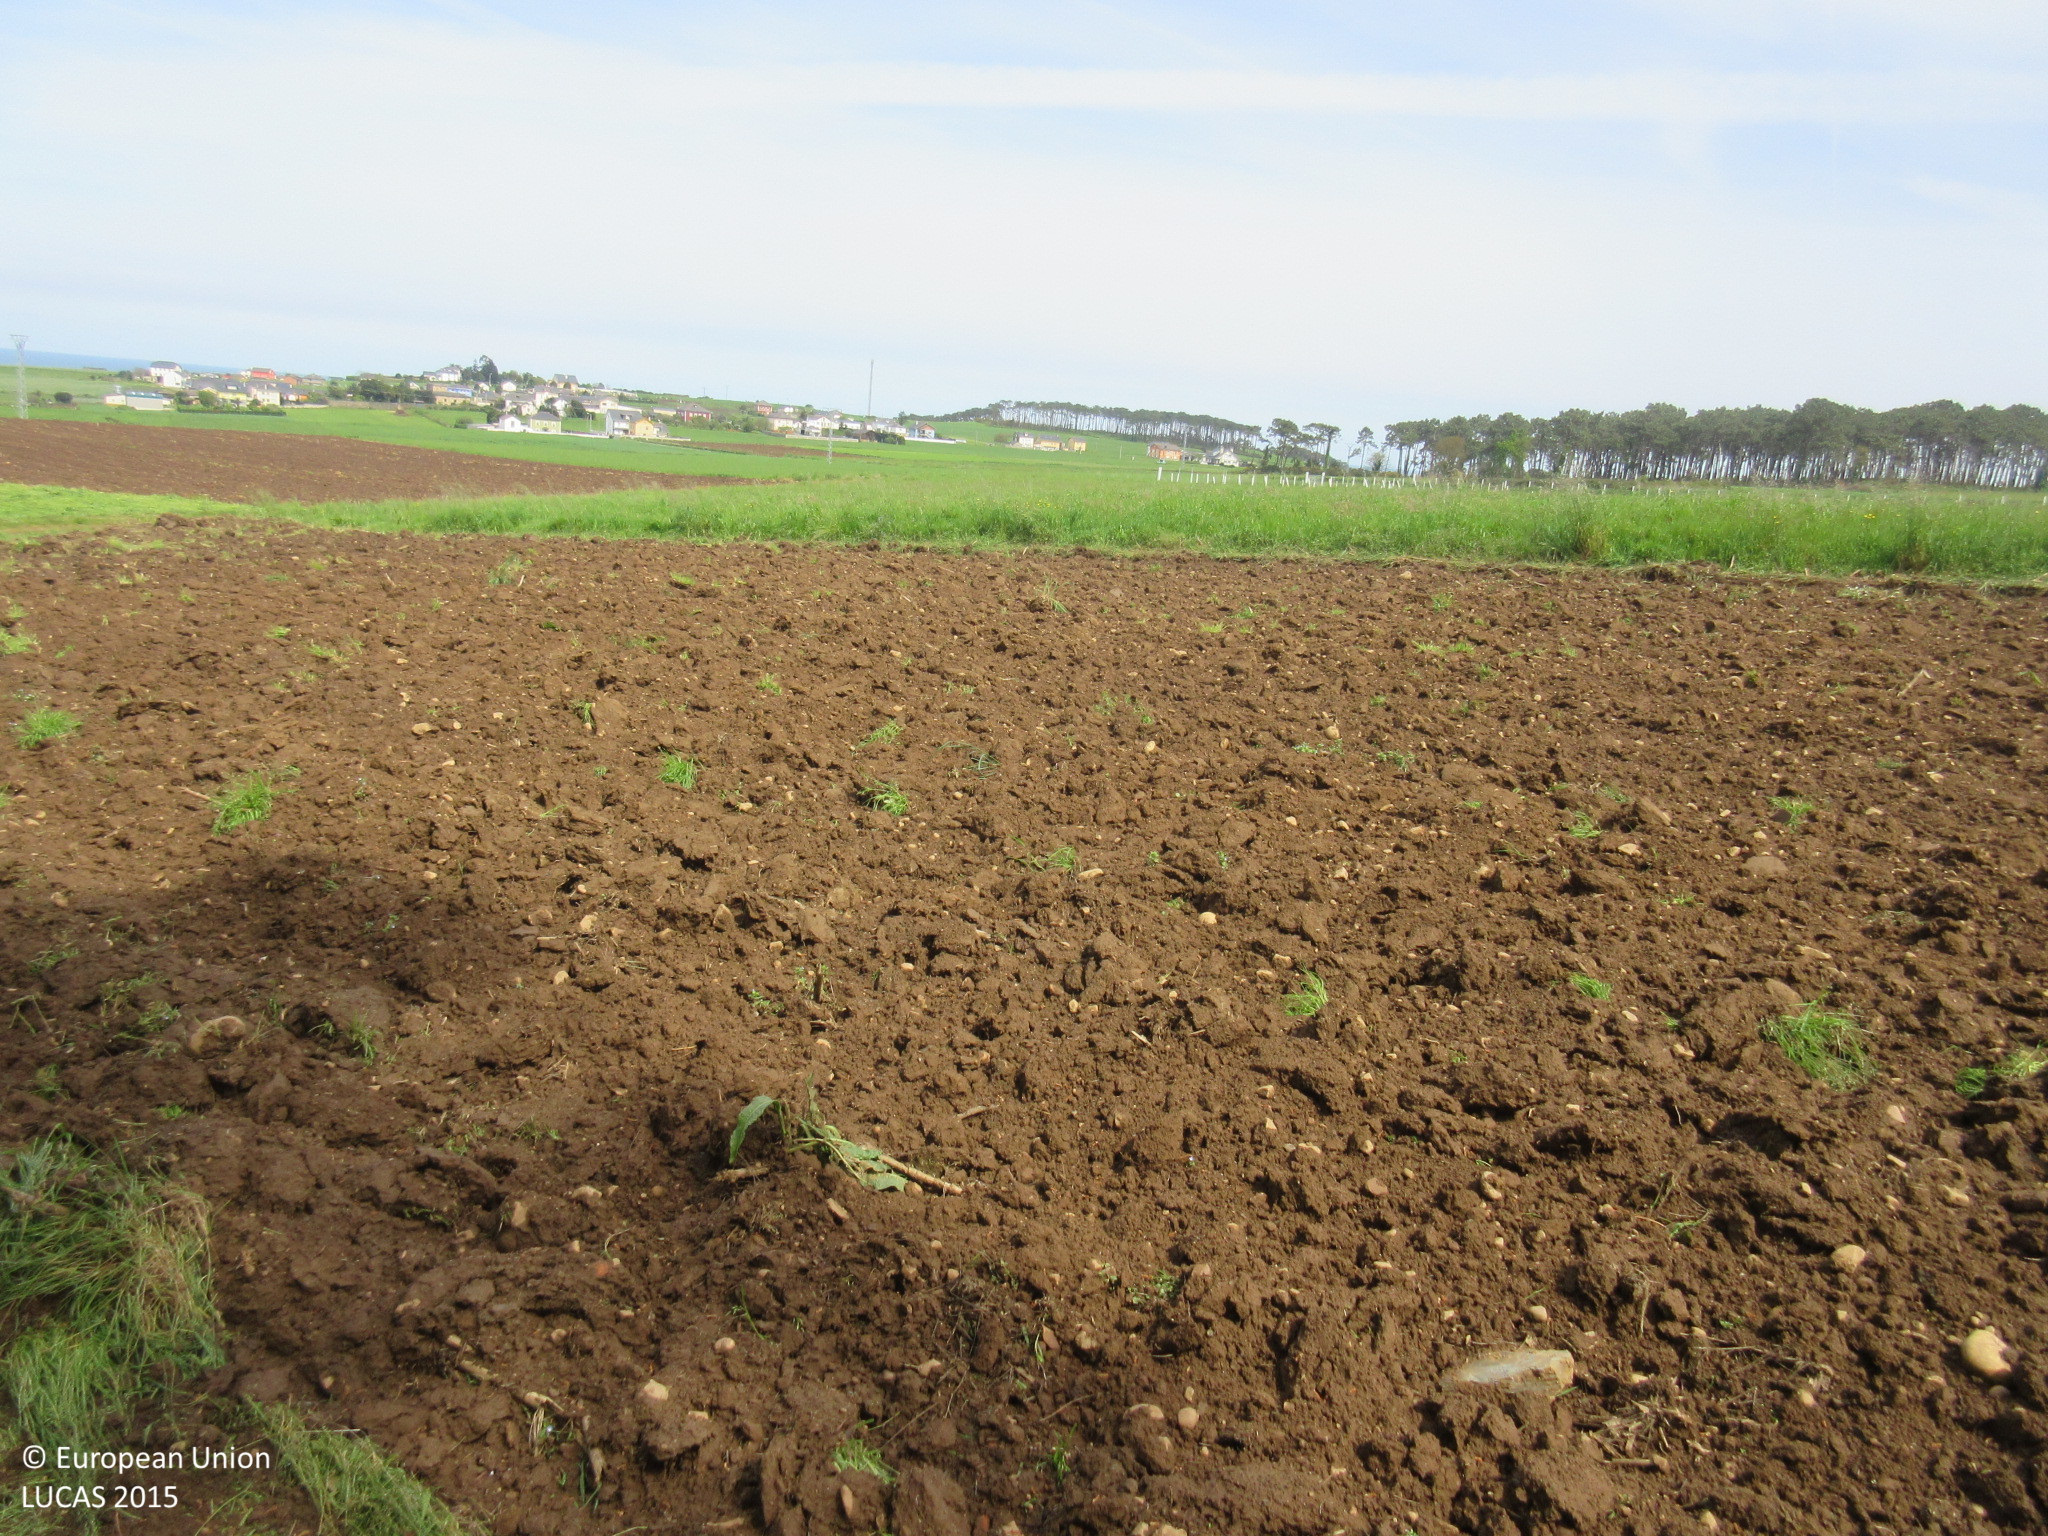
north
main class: Woodland
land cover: Pine dominated coniferous woodland
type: exotic forest
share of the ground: > 75 %
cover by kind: coniferous forest trees 100 %
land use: Forestry
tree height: > 5 m
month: April
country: ES
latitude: 43.5484
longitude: -6.6323
